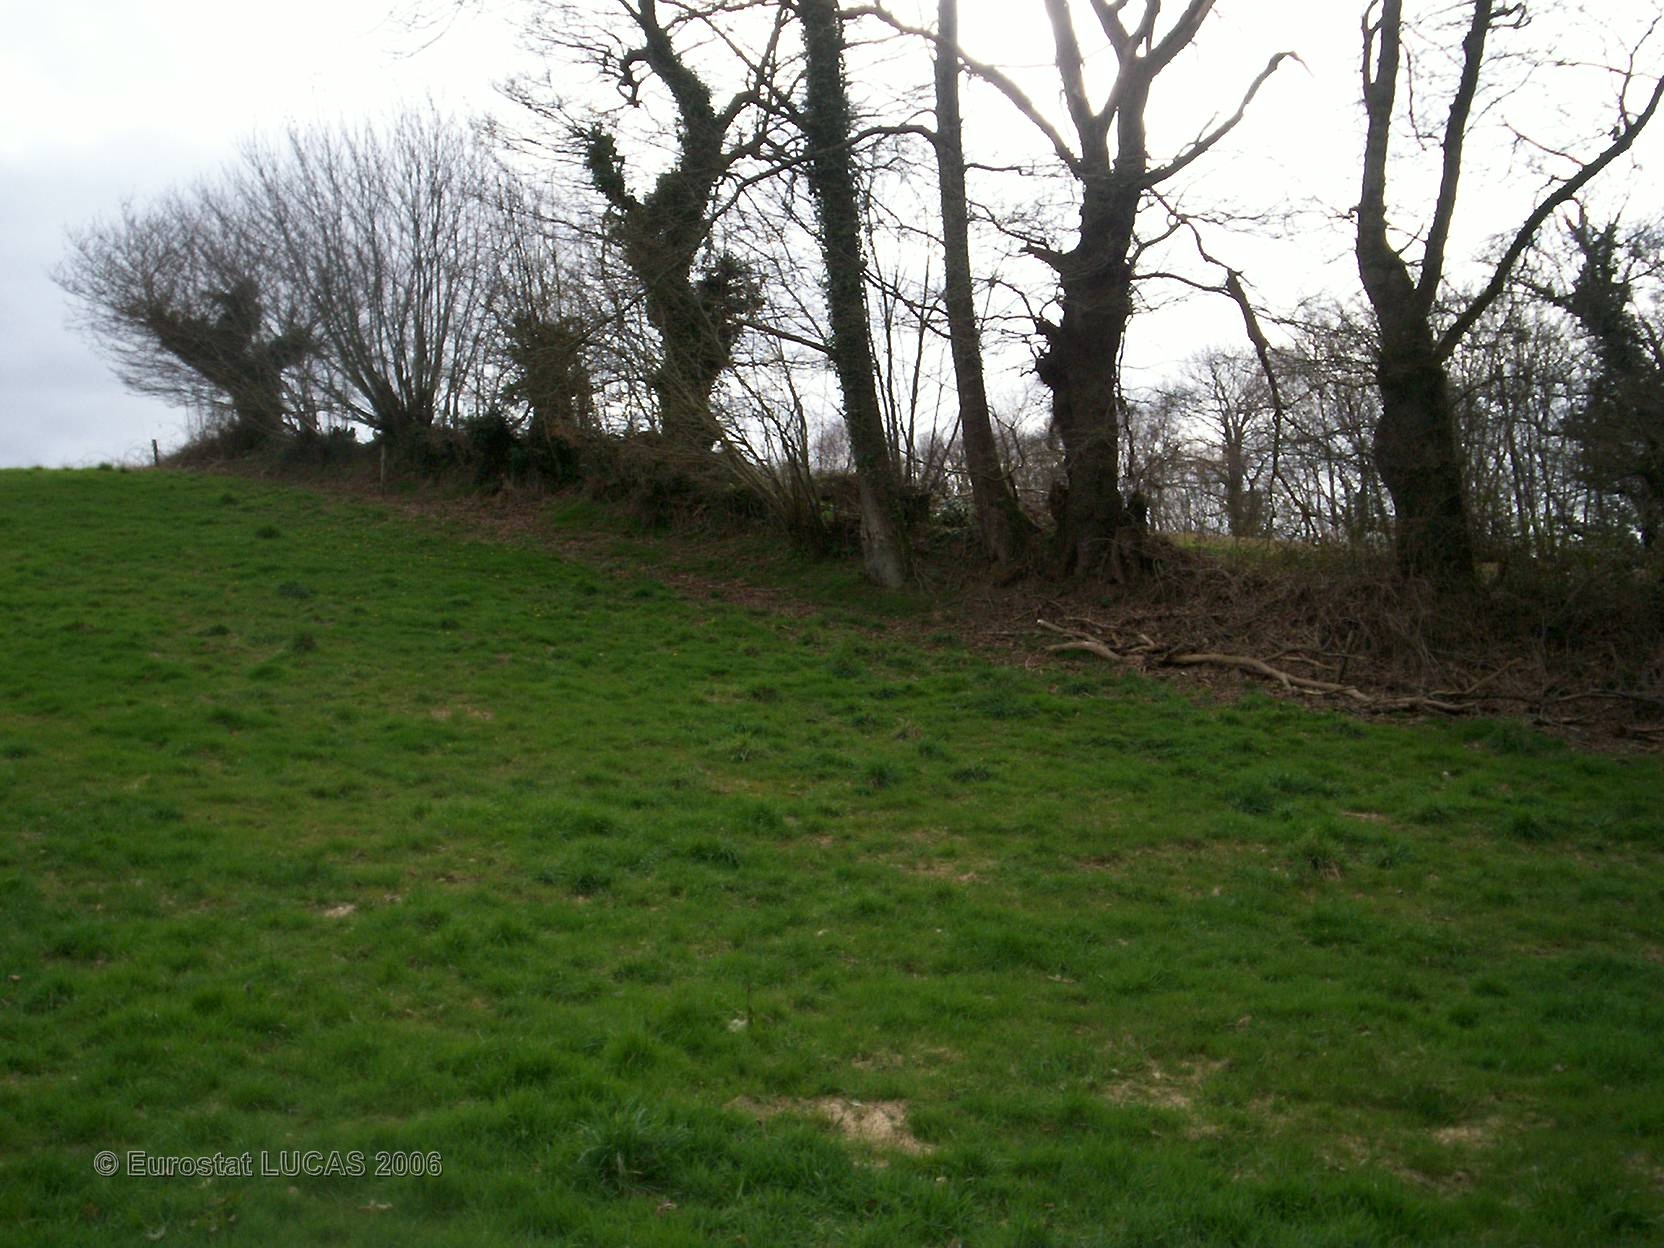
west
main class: Grassland
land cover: Grassland without tree/shrub cover
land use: Agriculture (excluding fallow land and kitchen gardens)
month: April
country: FR
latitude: 48.0667
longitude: -3.6198
